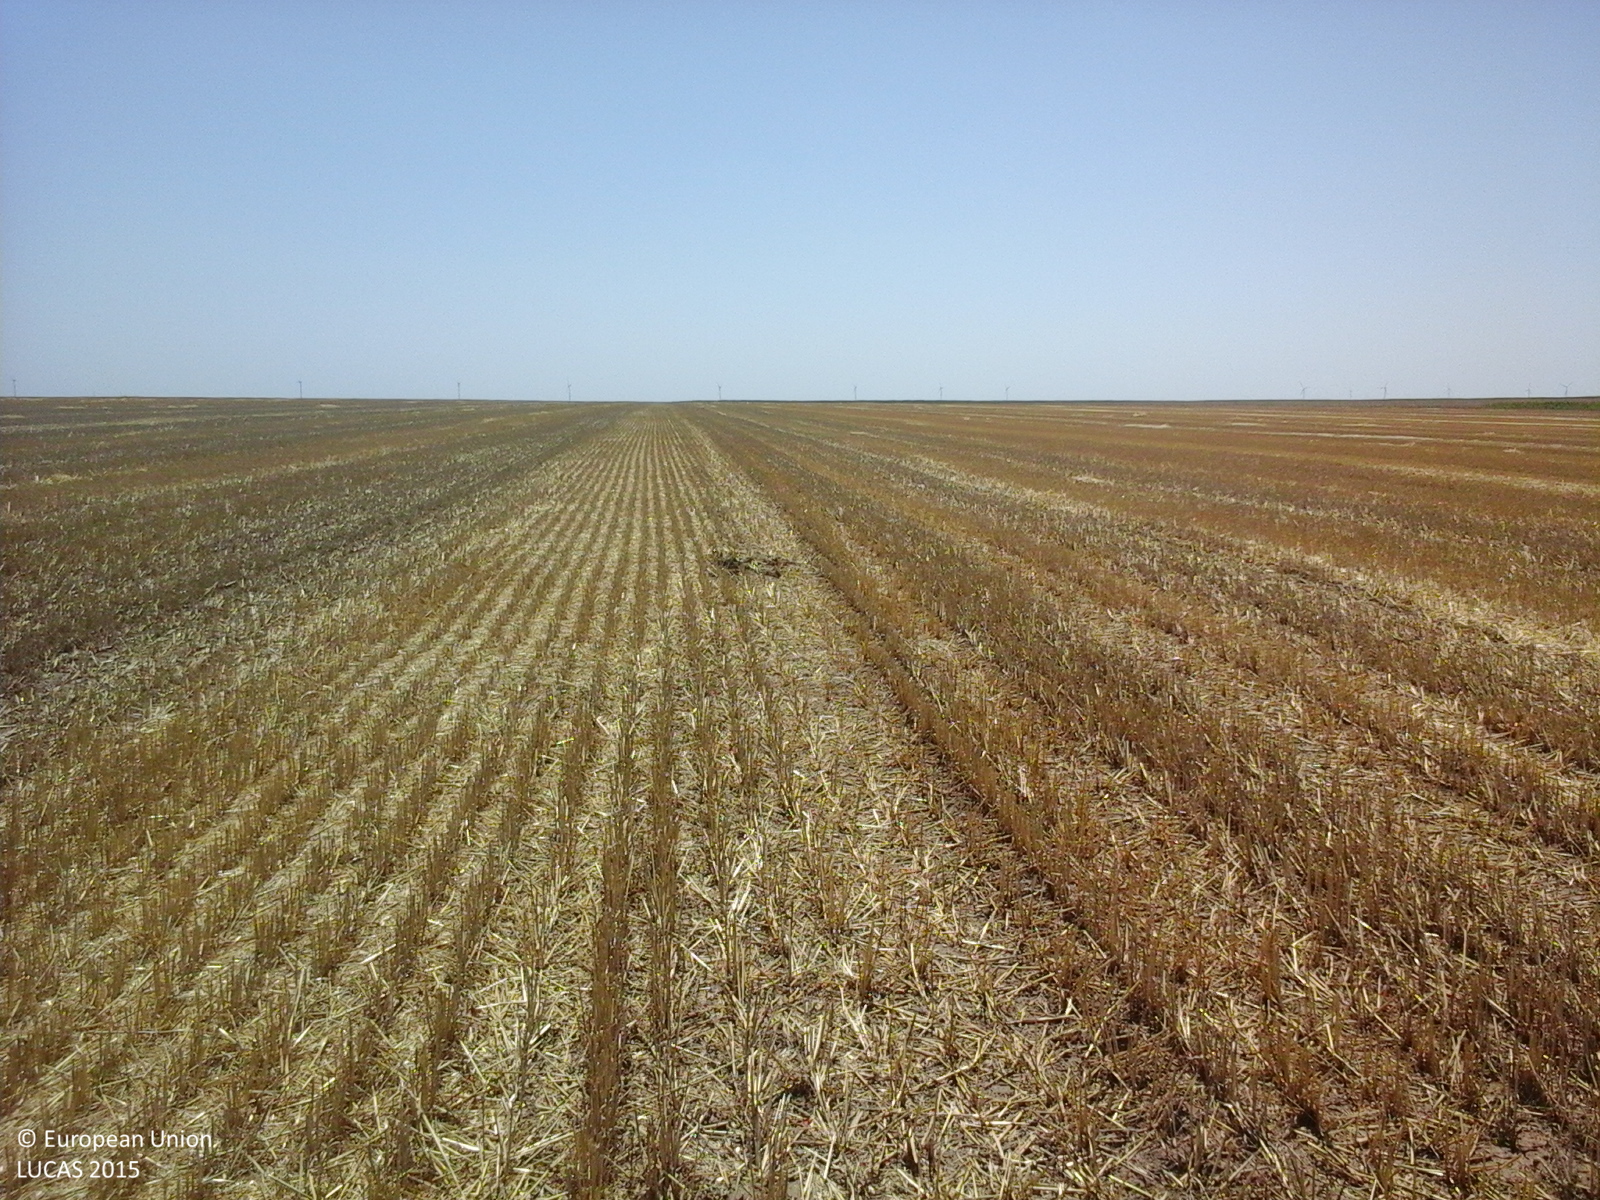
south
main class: Cropland
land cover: Common wheat
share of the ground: 50 - 75 %
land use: Agriculture (excluding fallow land and kitchen gardens)
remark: Harvested field
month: August
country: RO
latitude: 44.4721
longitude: 28.2292
